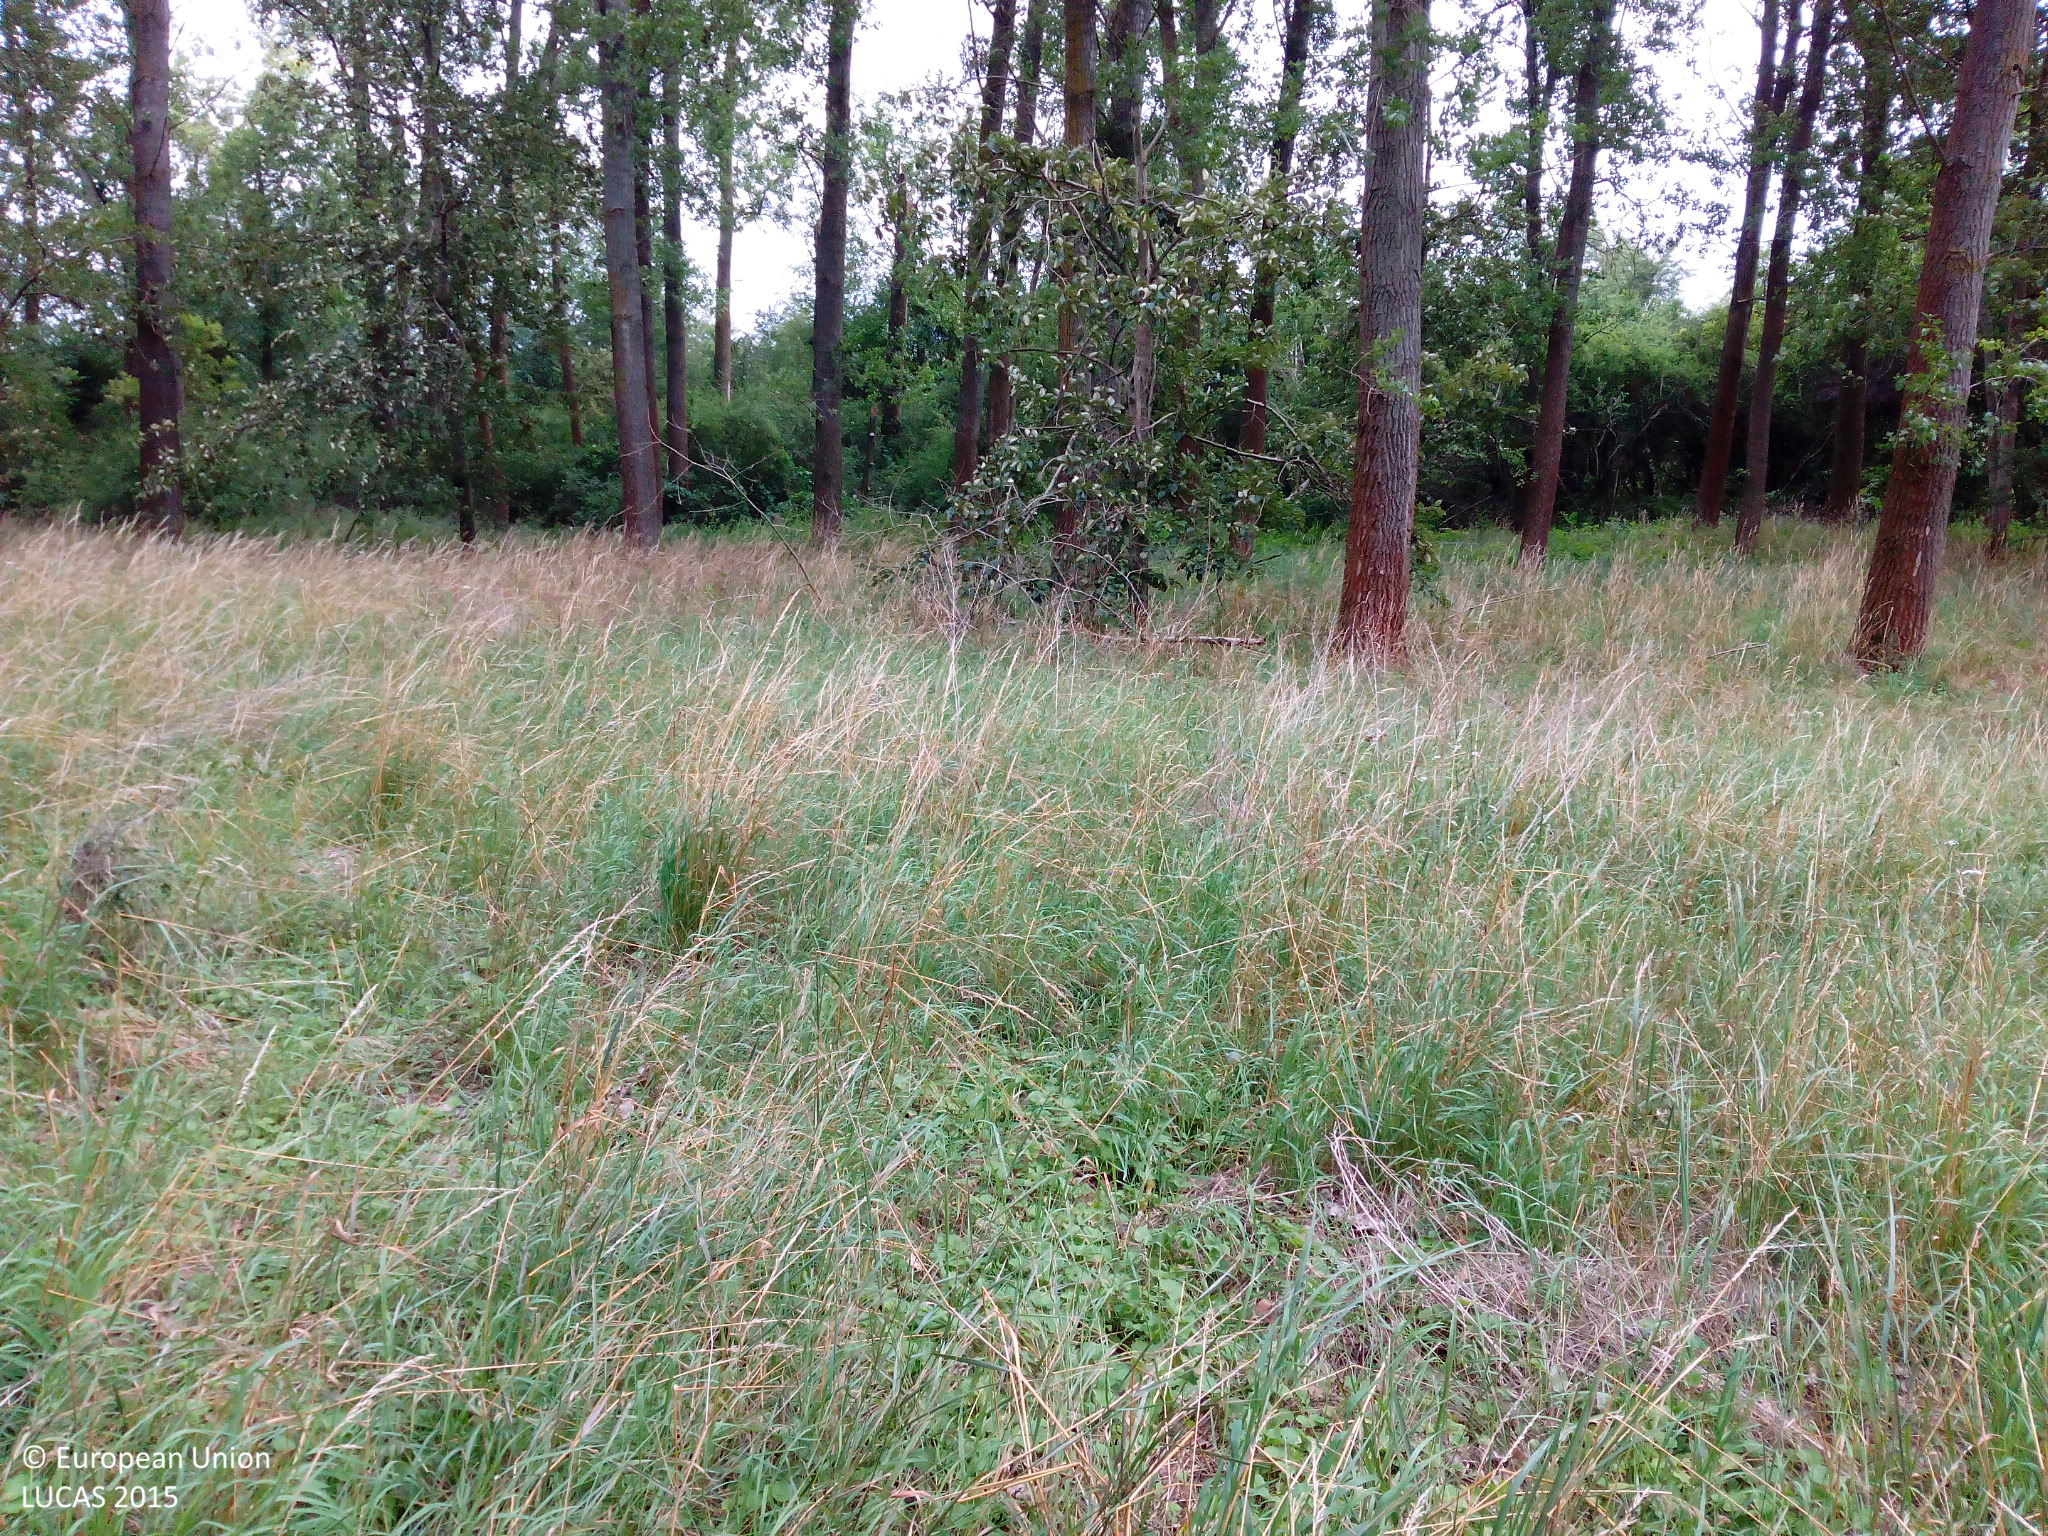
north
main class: Woodland
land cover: Broadleaved woodland
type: mesophytic deciduous forest
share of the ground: > 75 %
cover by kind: broadleaved forest trees 75 %, herbaceous plants 25 %
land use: Forestry
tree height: > 5 m
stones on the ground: < 10 %
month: July
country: DE
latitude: 52.7375
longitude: 14.1331
